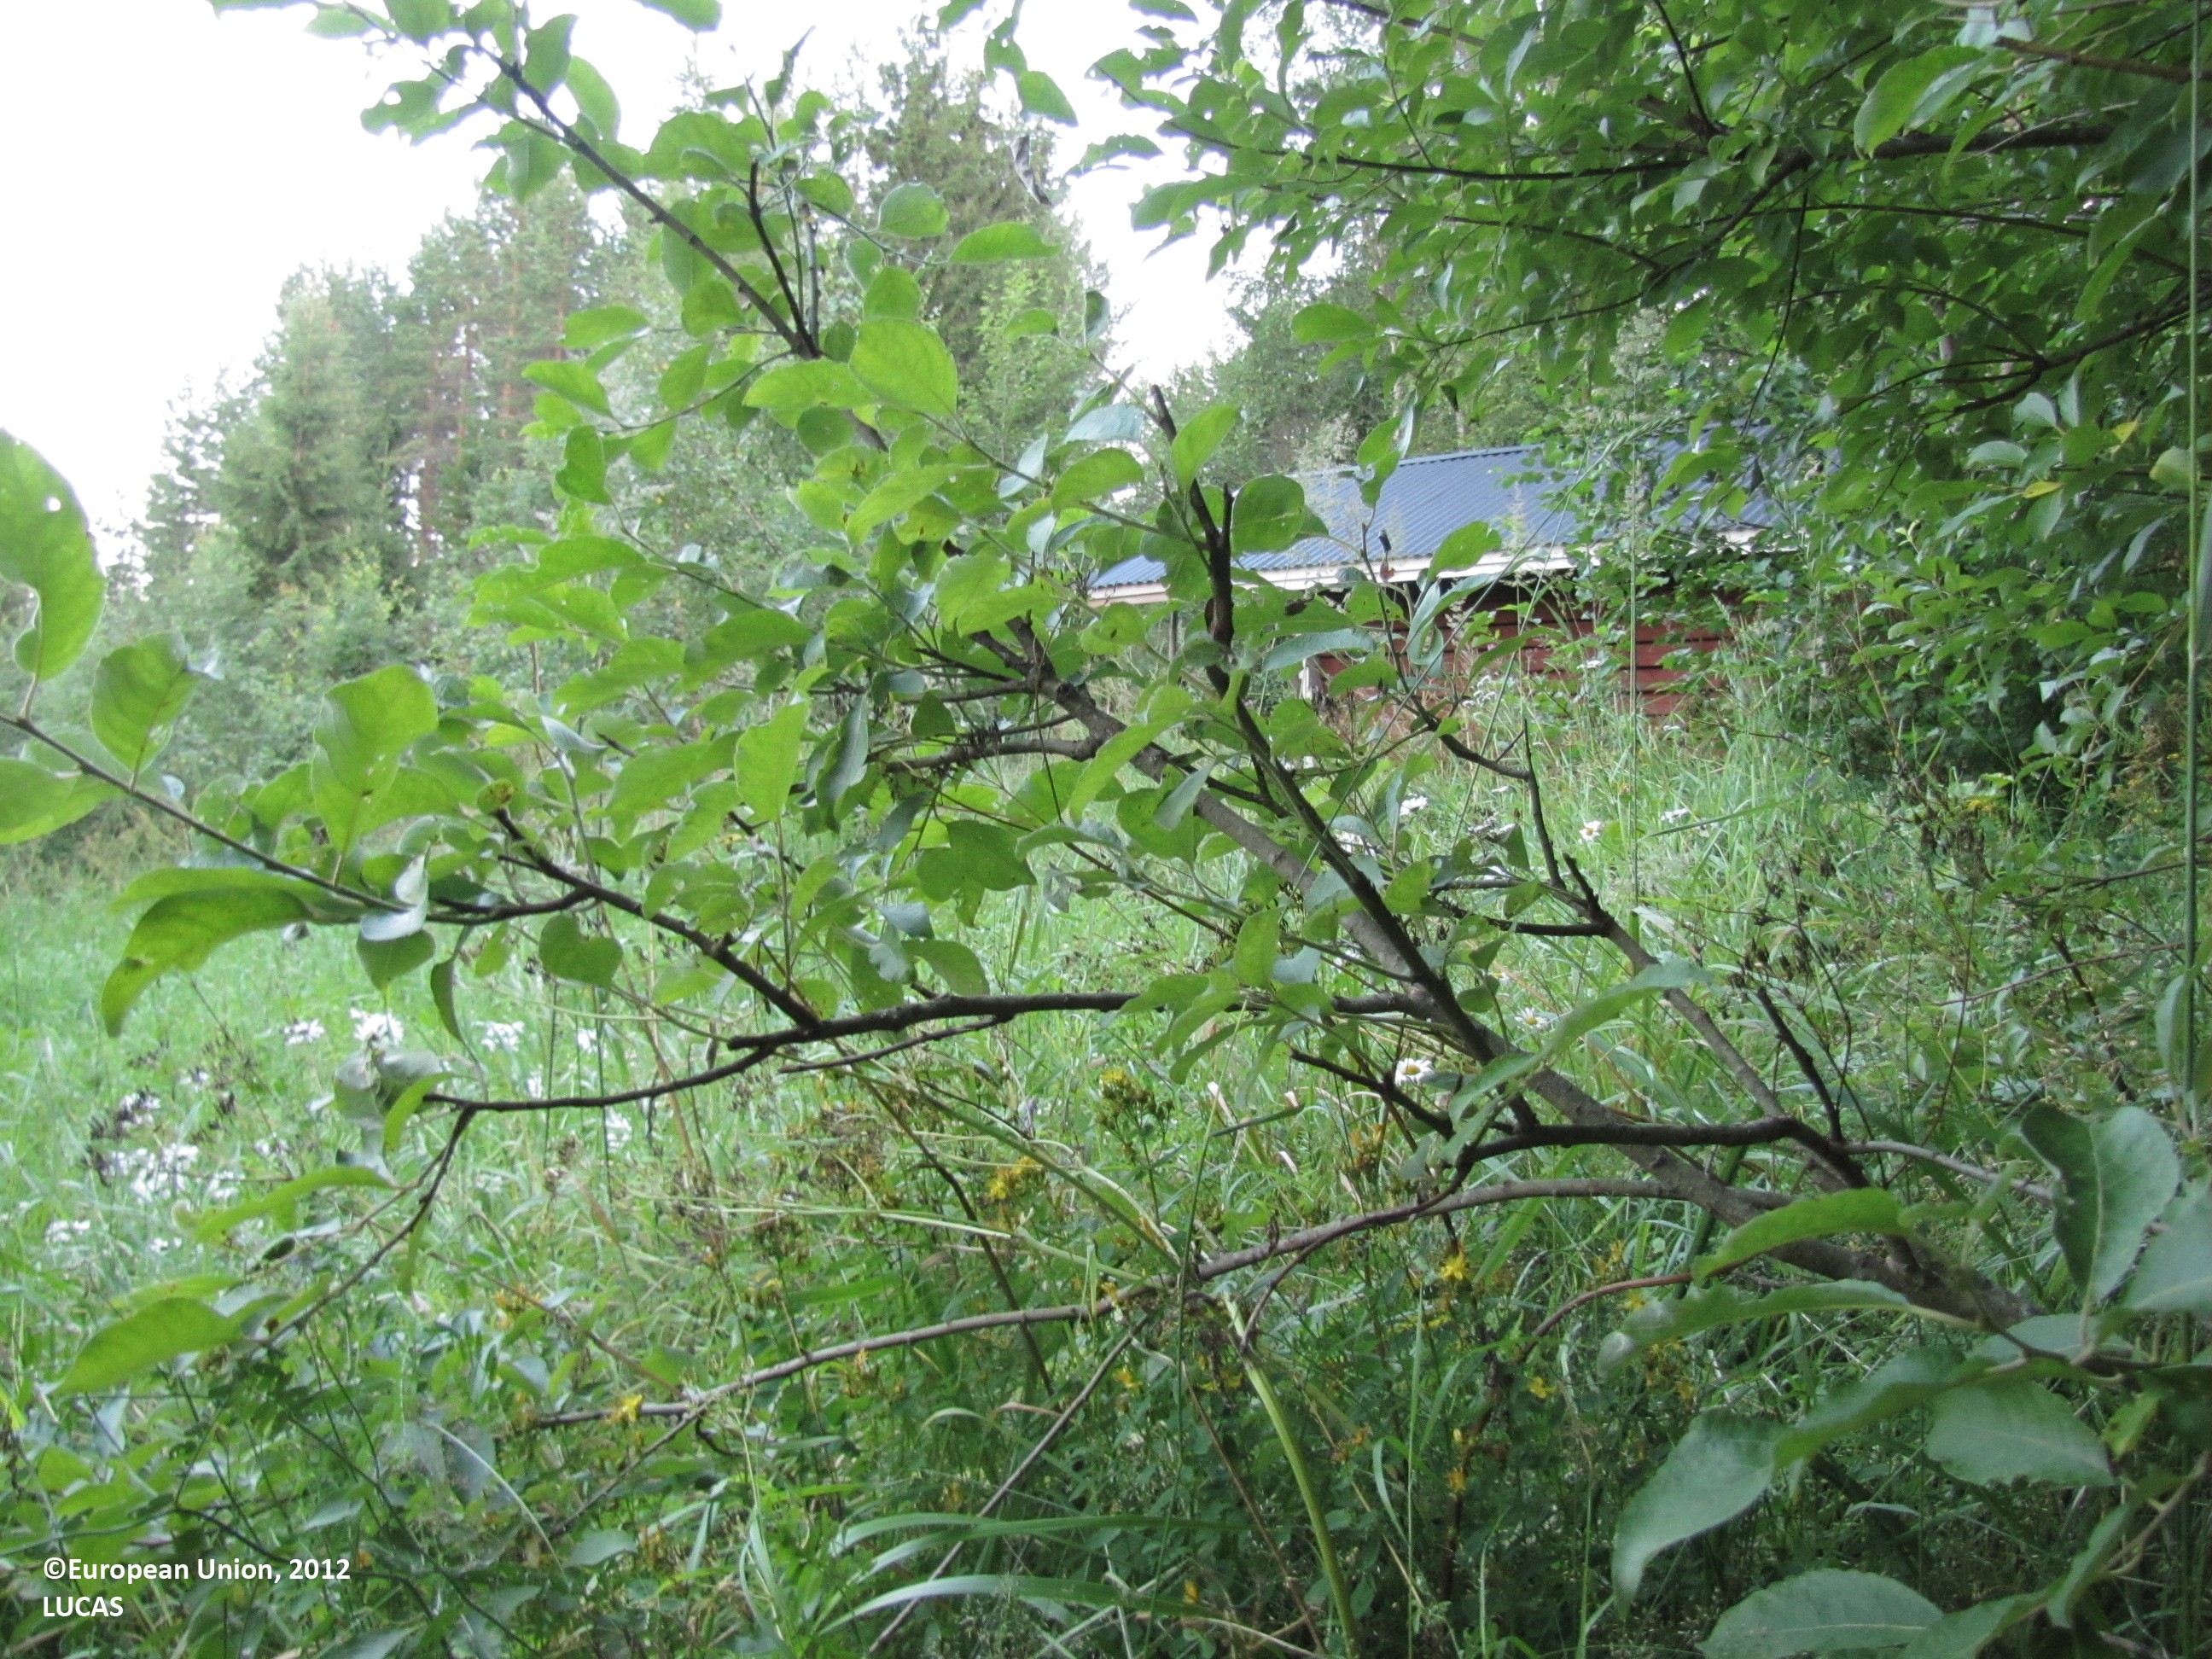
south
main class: Woodland
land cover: Other mixed woodland
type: boreal forest
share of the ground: 25 - 50 %
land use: Forestry
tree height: > 5 m
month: July
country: FI
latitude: 61.9661
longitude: 23.8717
